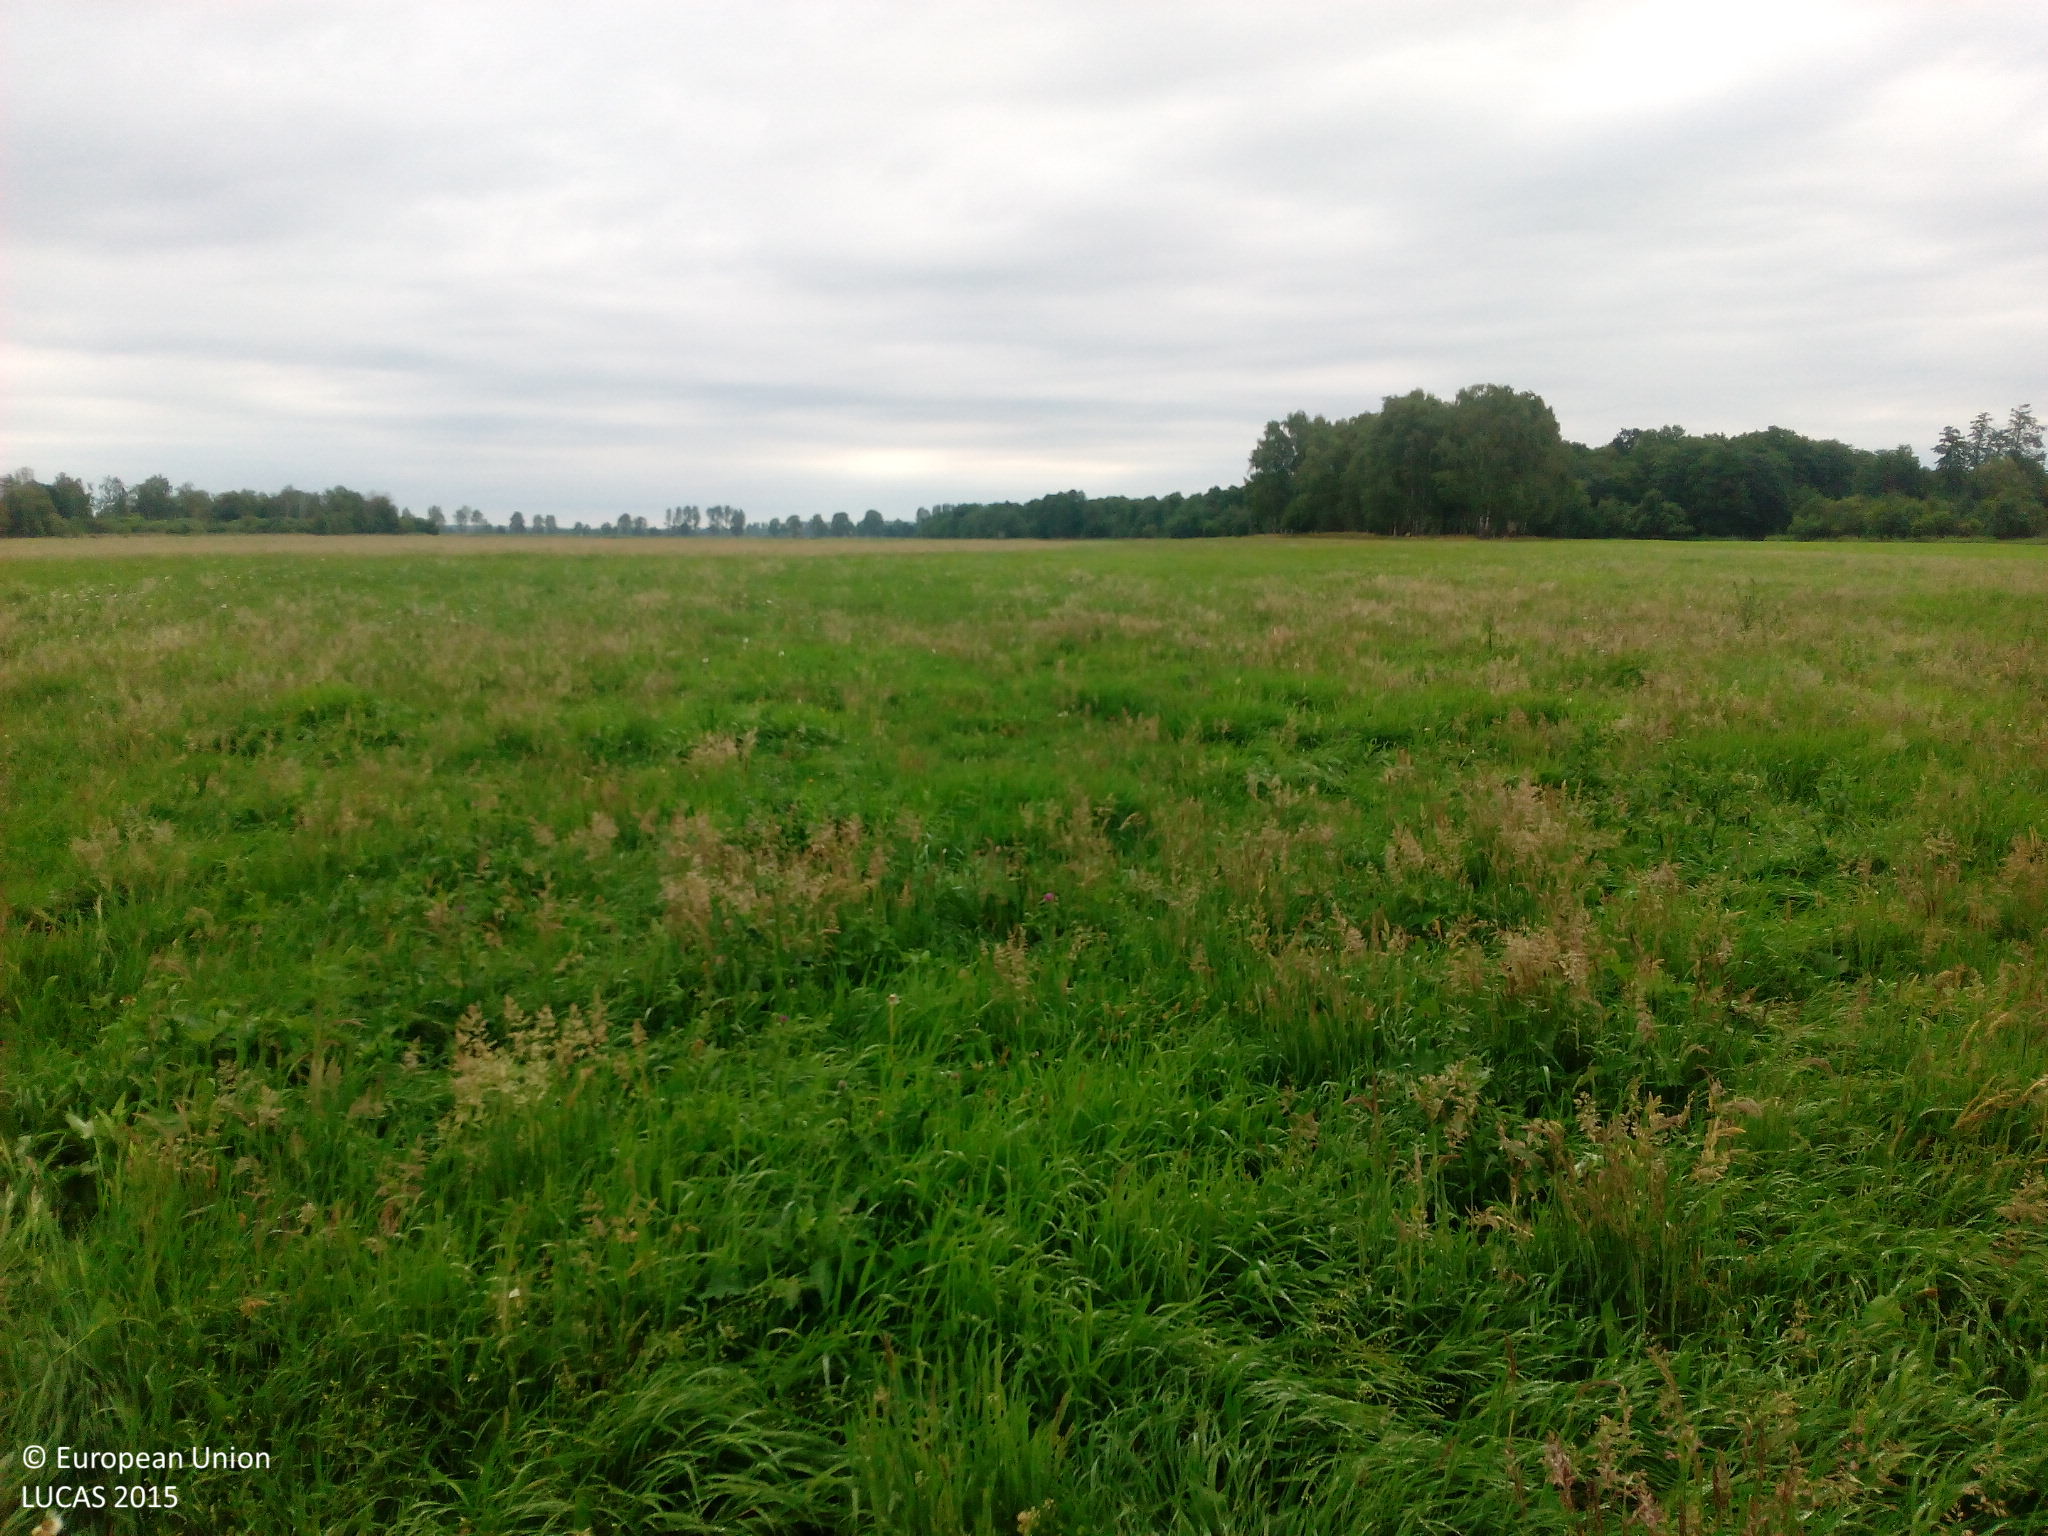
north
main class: Grassland
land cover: Grassland without tree/shrub cover
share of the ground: > 75 %
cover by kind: herbaceous plants 100 %
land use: Agriculture (excluding fallow land and kitchen gardens)
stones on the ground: < 10 %
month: July
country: DE
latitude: 53.5448
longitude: 14.2111
